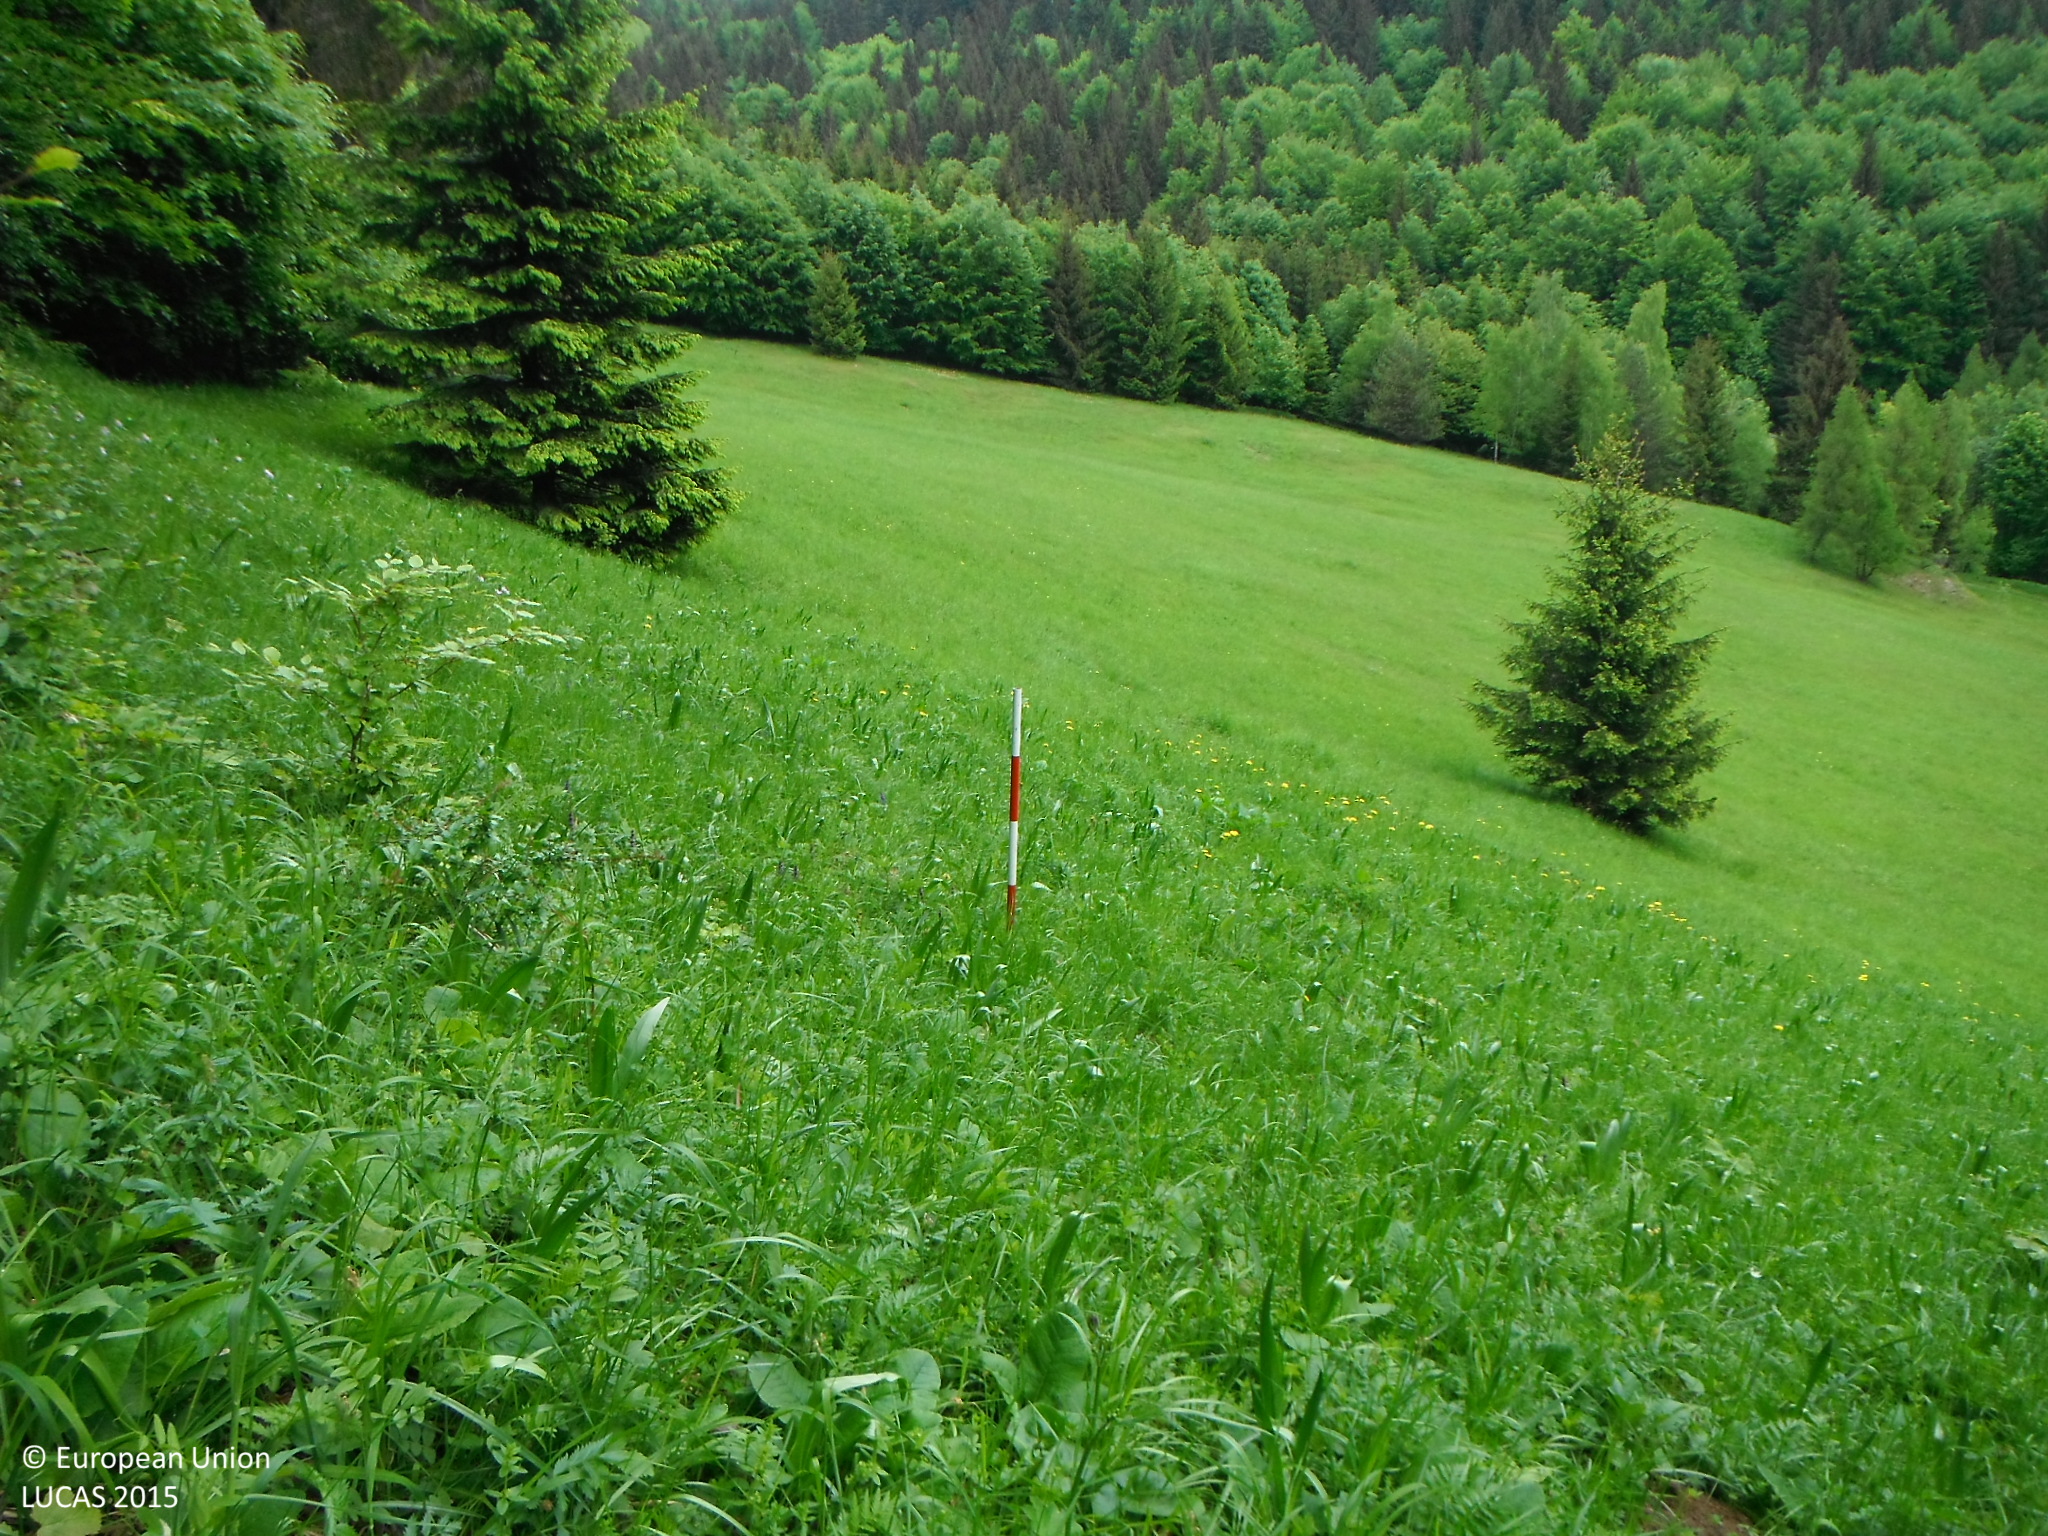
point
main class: Grassland
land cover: Grassland without tree/shrub cover
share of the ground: > 75 %
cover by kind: herbaceous plants 100 %
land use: Agriculture (excluding fallow land and kitchen gardens)
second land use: Sport
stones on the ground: < 10 %
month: May
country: SK
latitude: 48.8013
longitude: 19.1580
